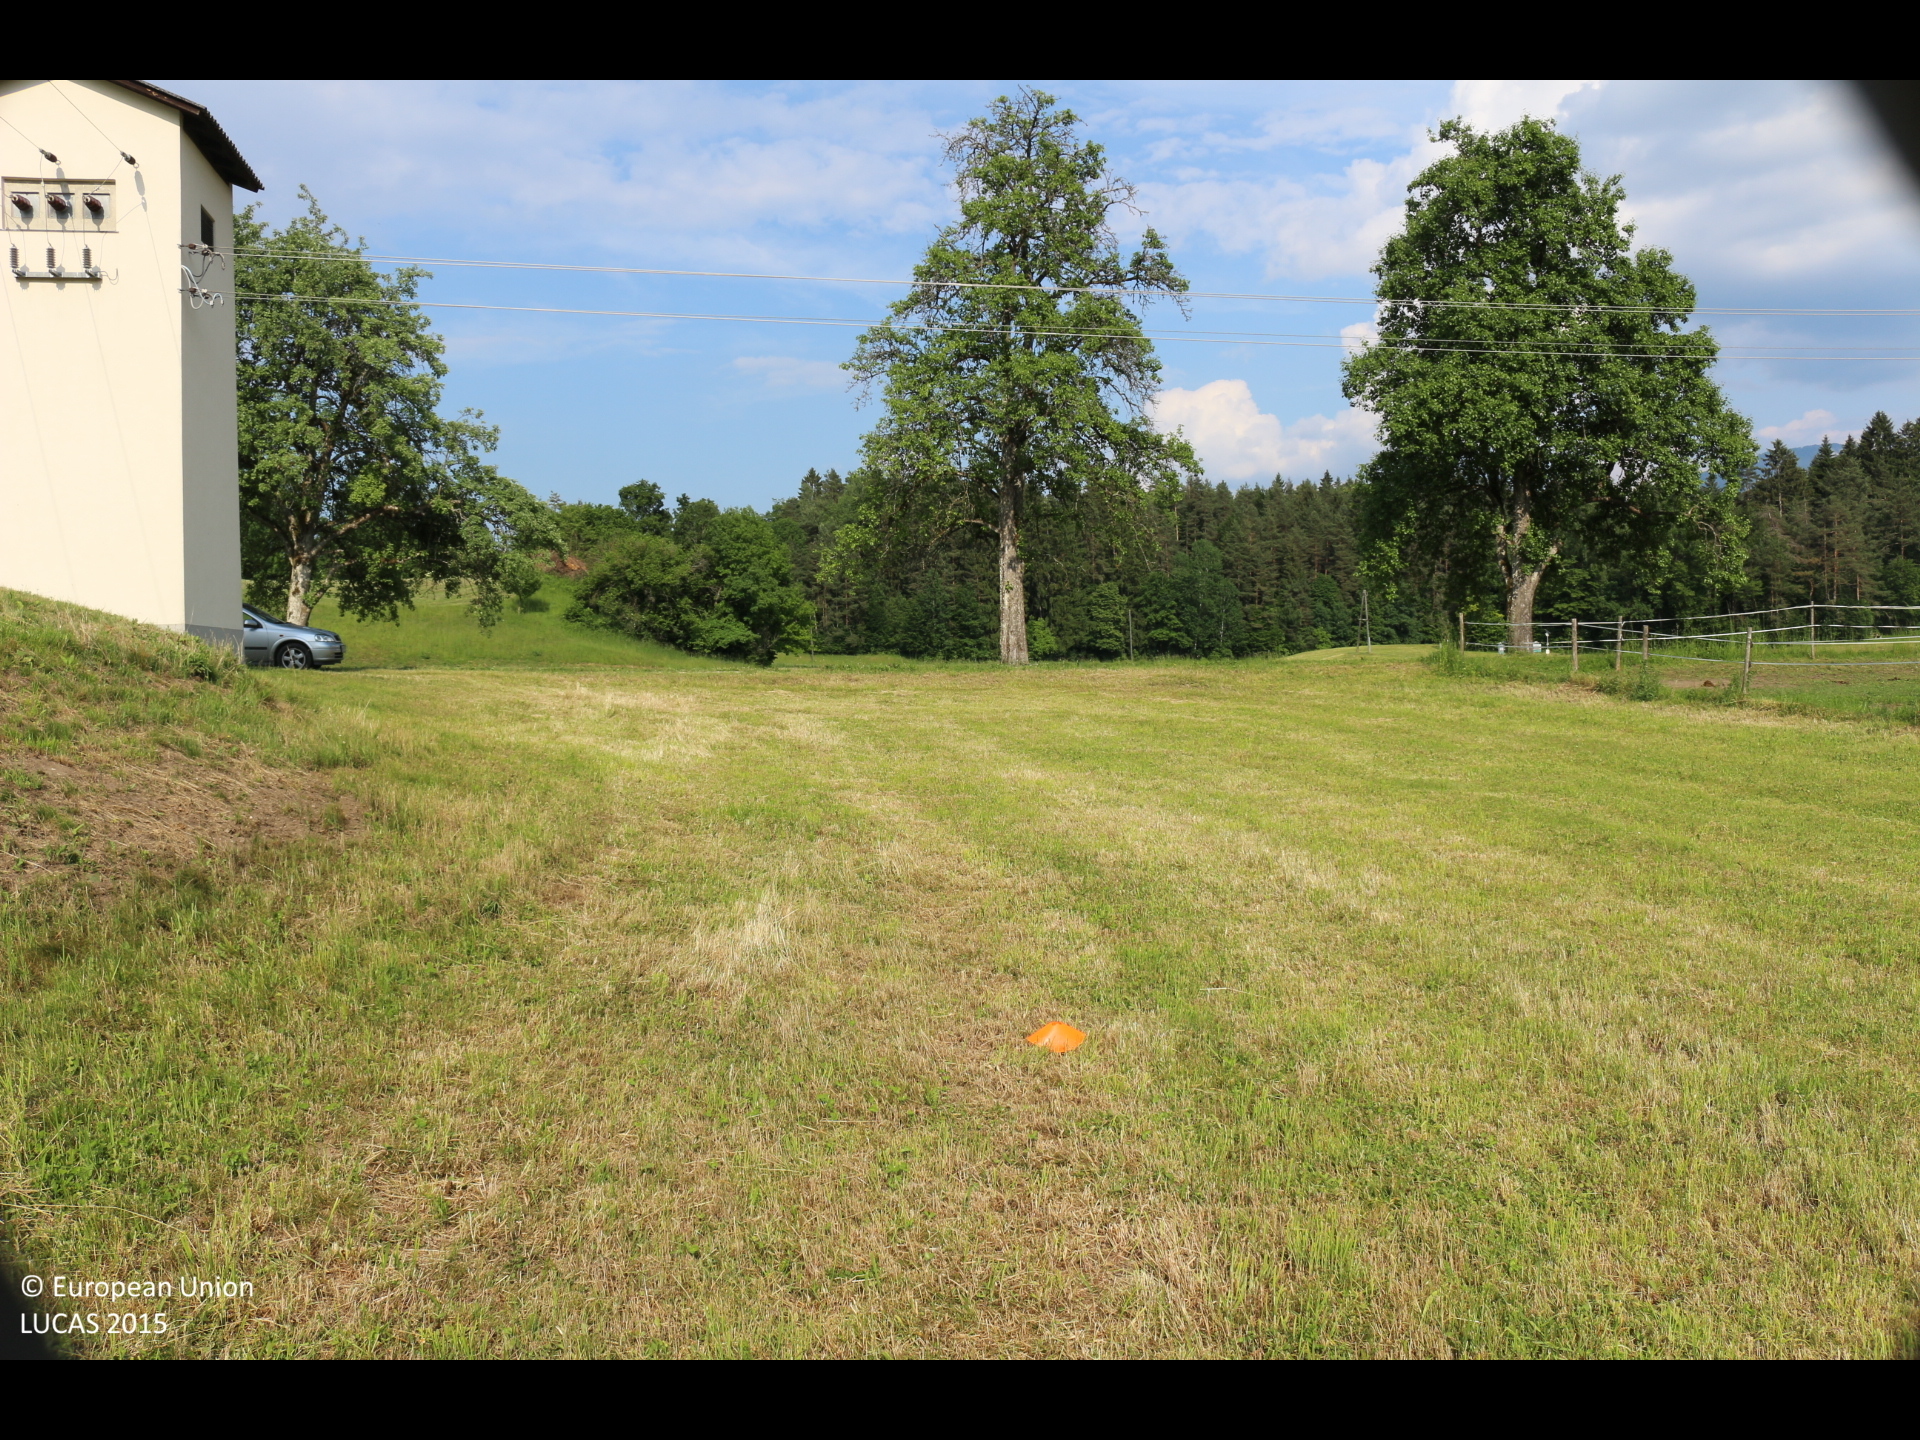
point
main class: Grassland
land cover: Grassland without tree/shrub cover
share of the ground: > 75 %
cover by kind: herbaceous plants 100 %
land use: Agriculture (excluding fallow land and kitchen gardens)
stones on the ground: < 10 %
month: June
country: AT
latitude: 46.5549
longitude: 14.2625
